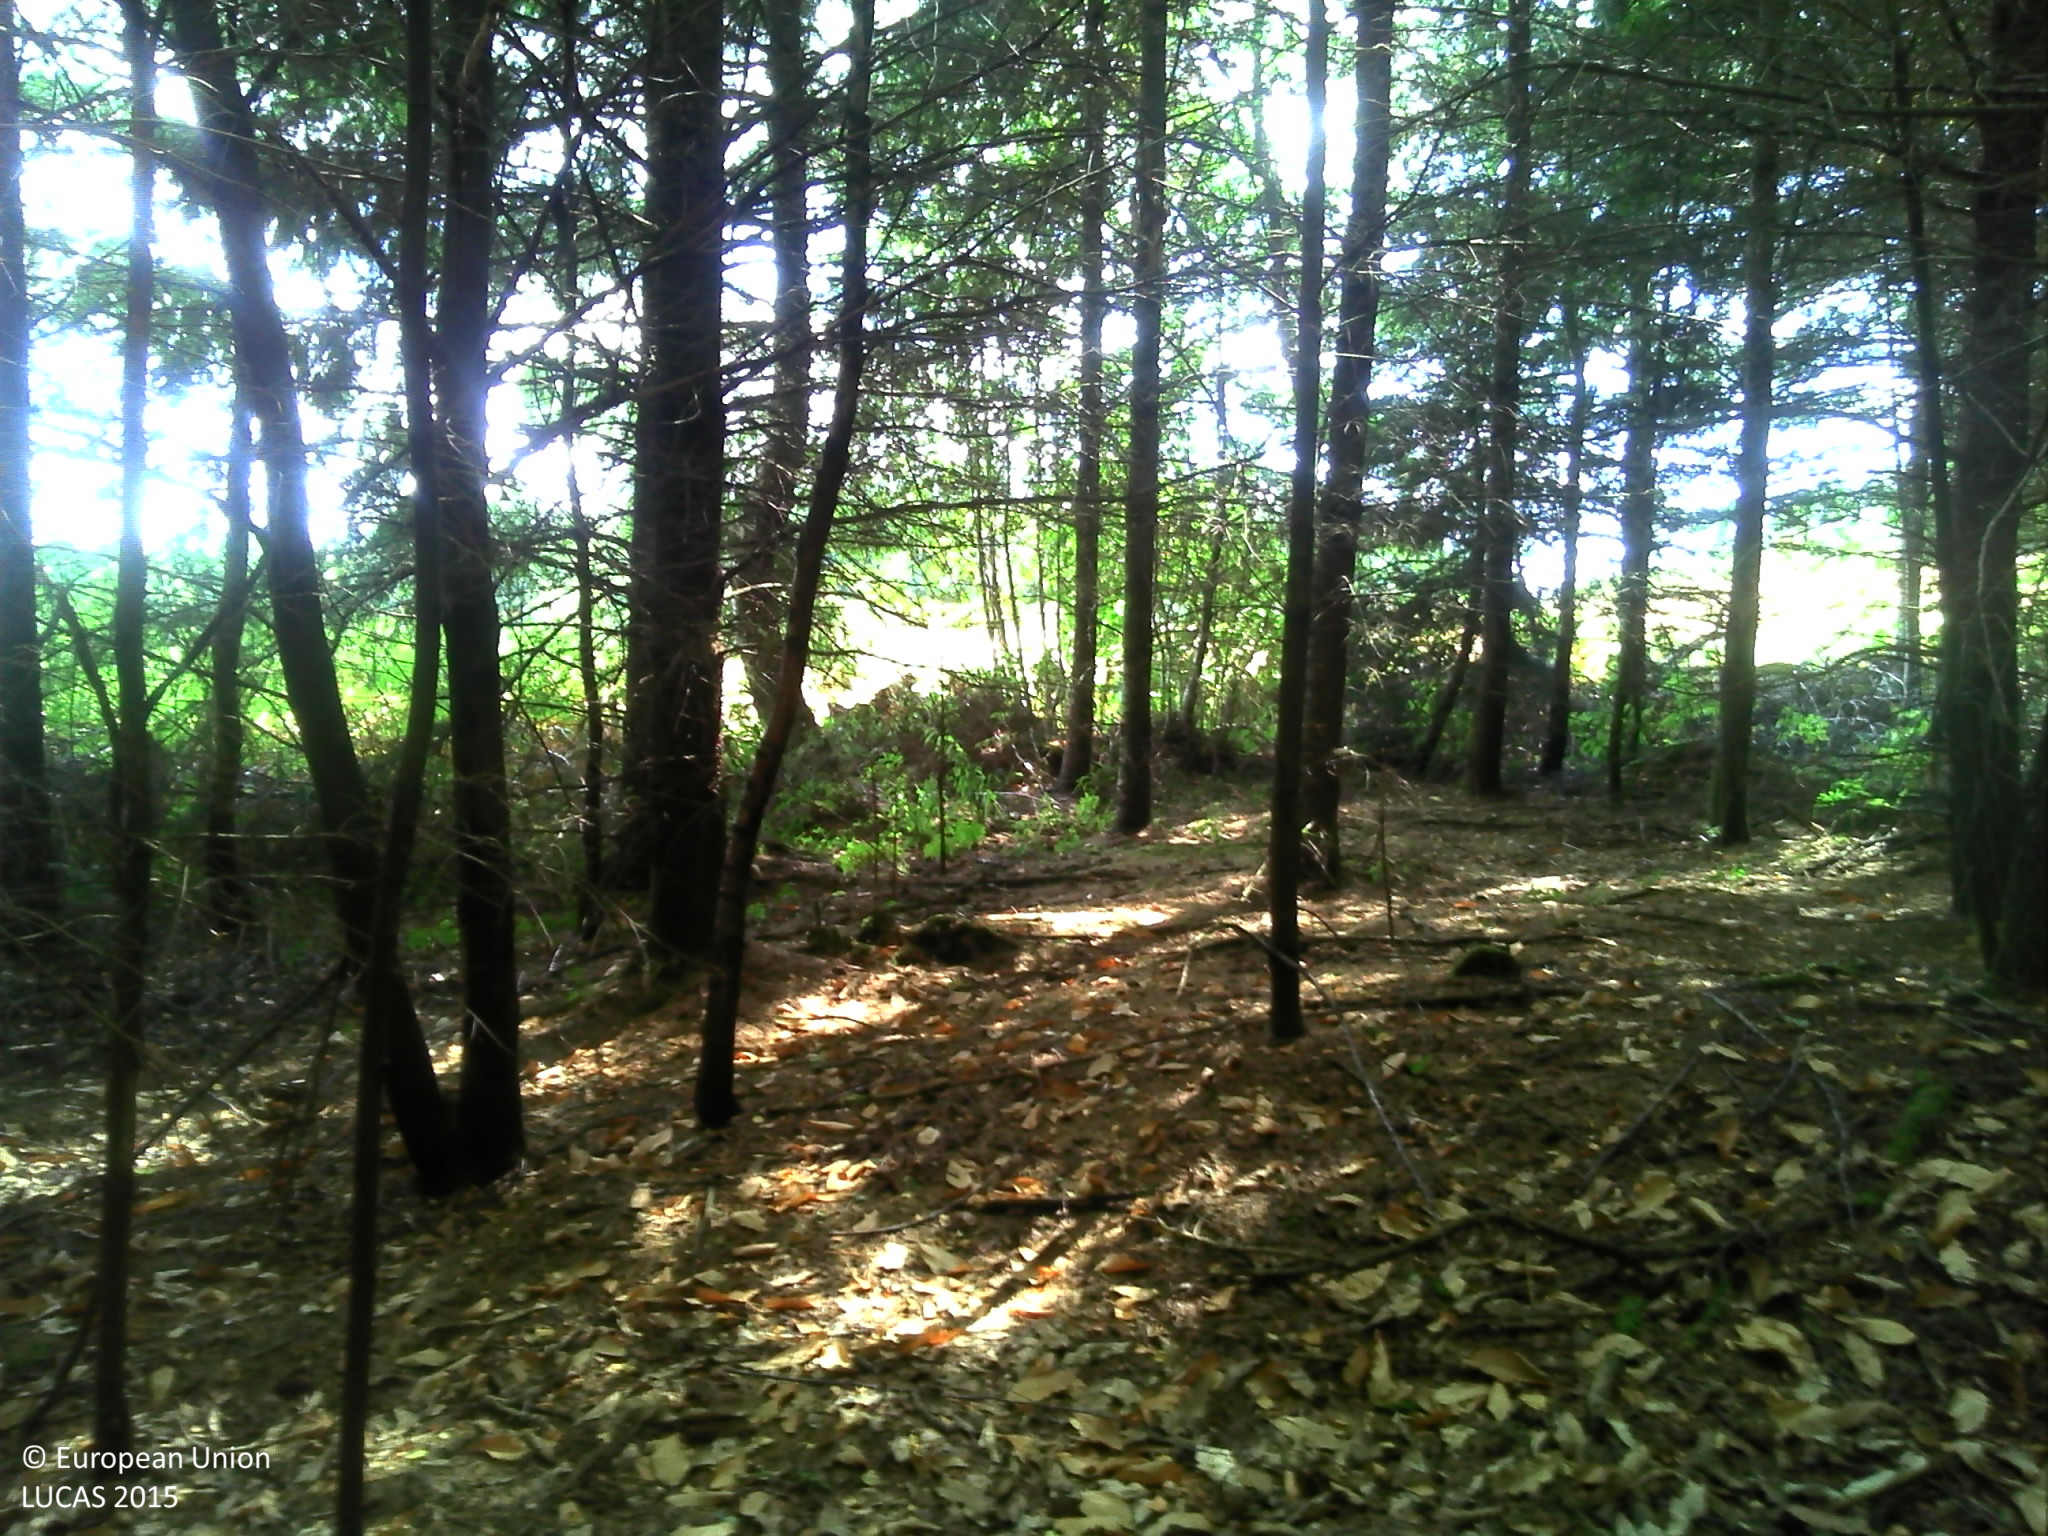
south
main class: Woodland
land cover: Spruce dominated coniferous woodland
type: exotic forest
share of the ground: > 75 %
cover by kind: coniferous forest trees 90 %, shrubs 5 %, herbaceous plants 5 %
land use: Forestry
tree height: > 5 m
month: July
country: FR
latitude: 46.0437
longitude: 4.4326
